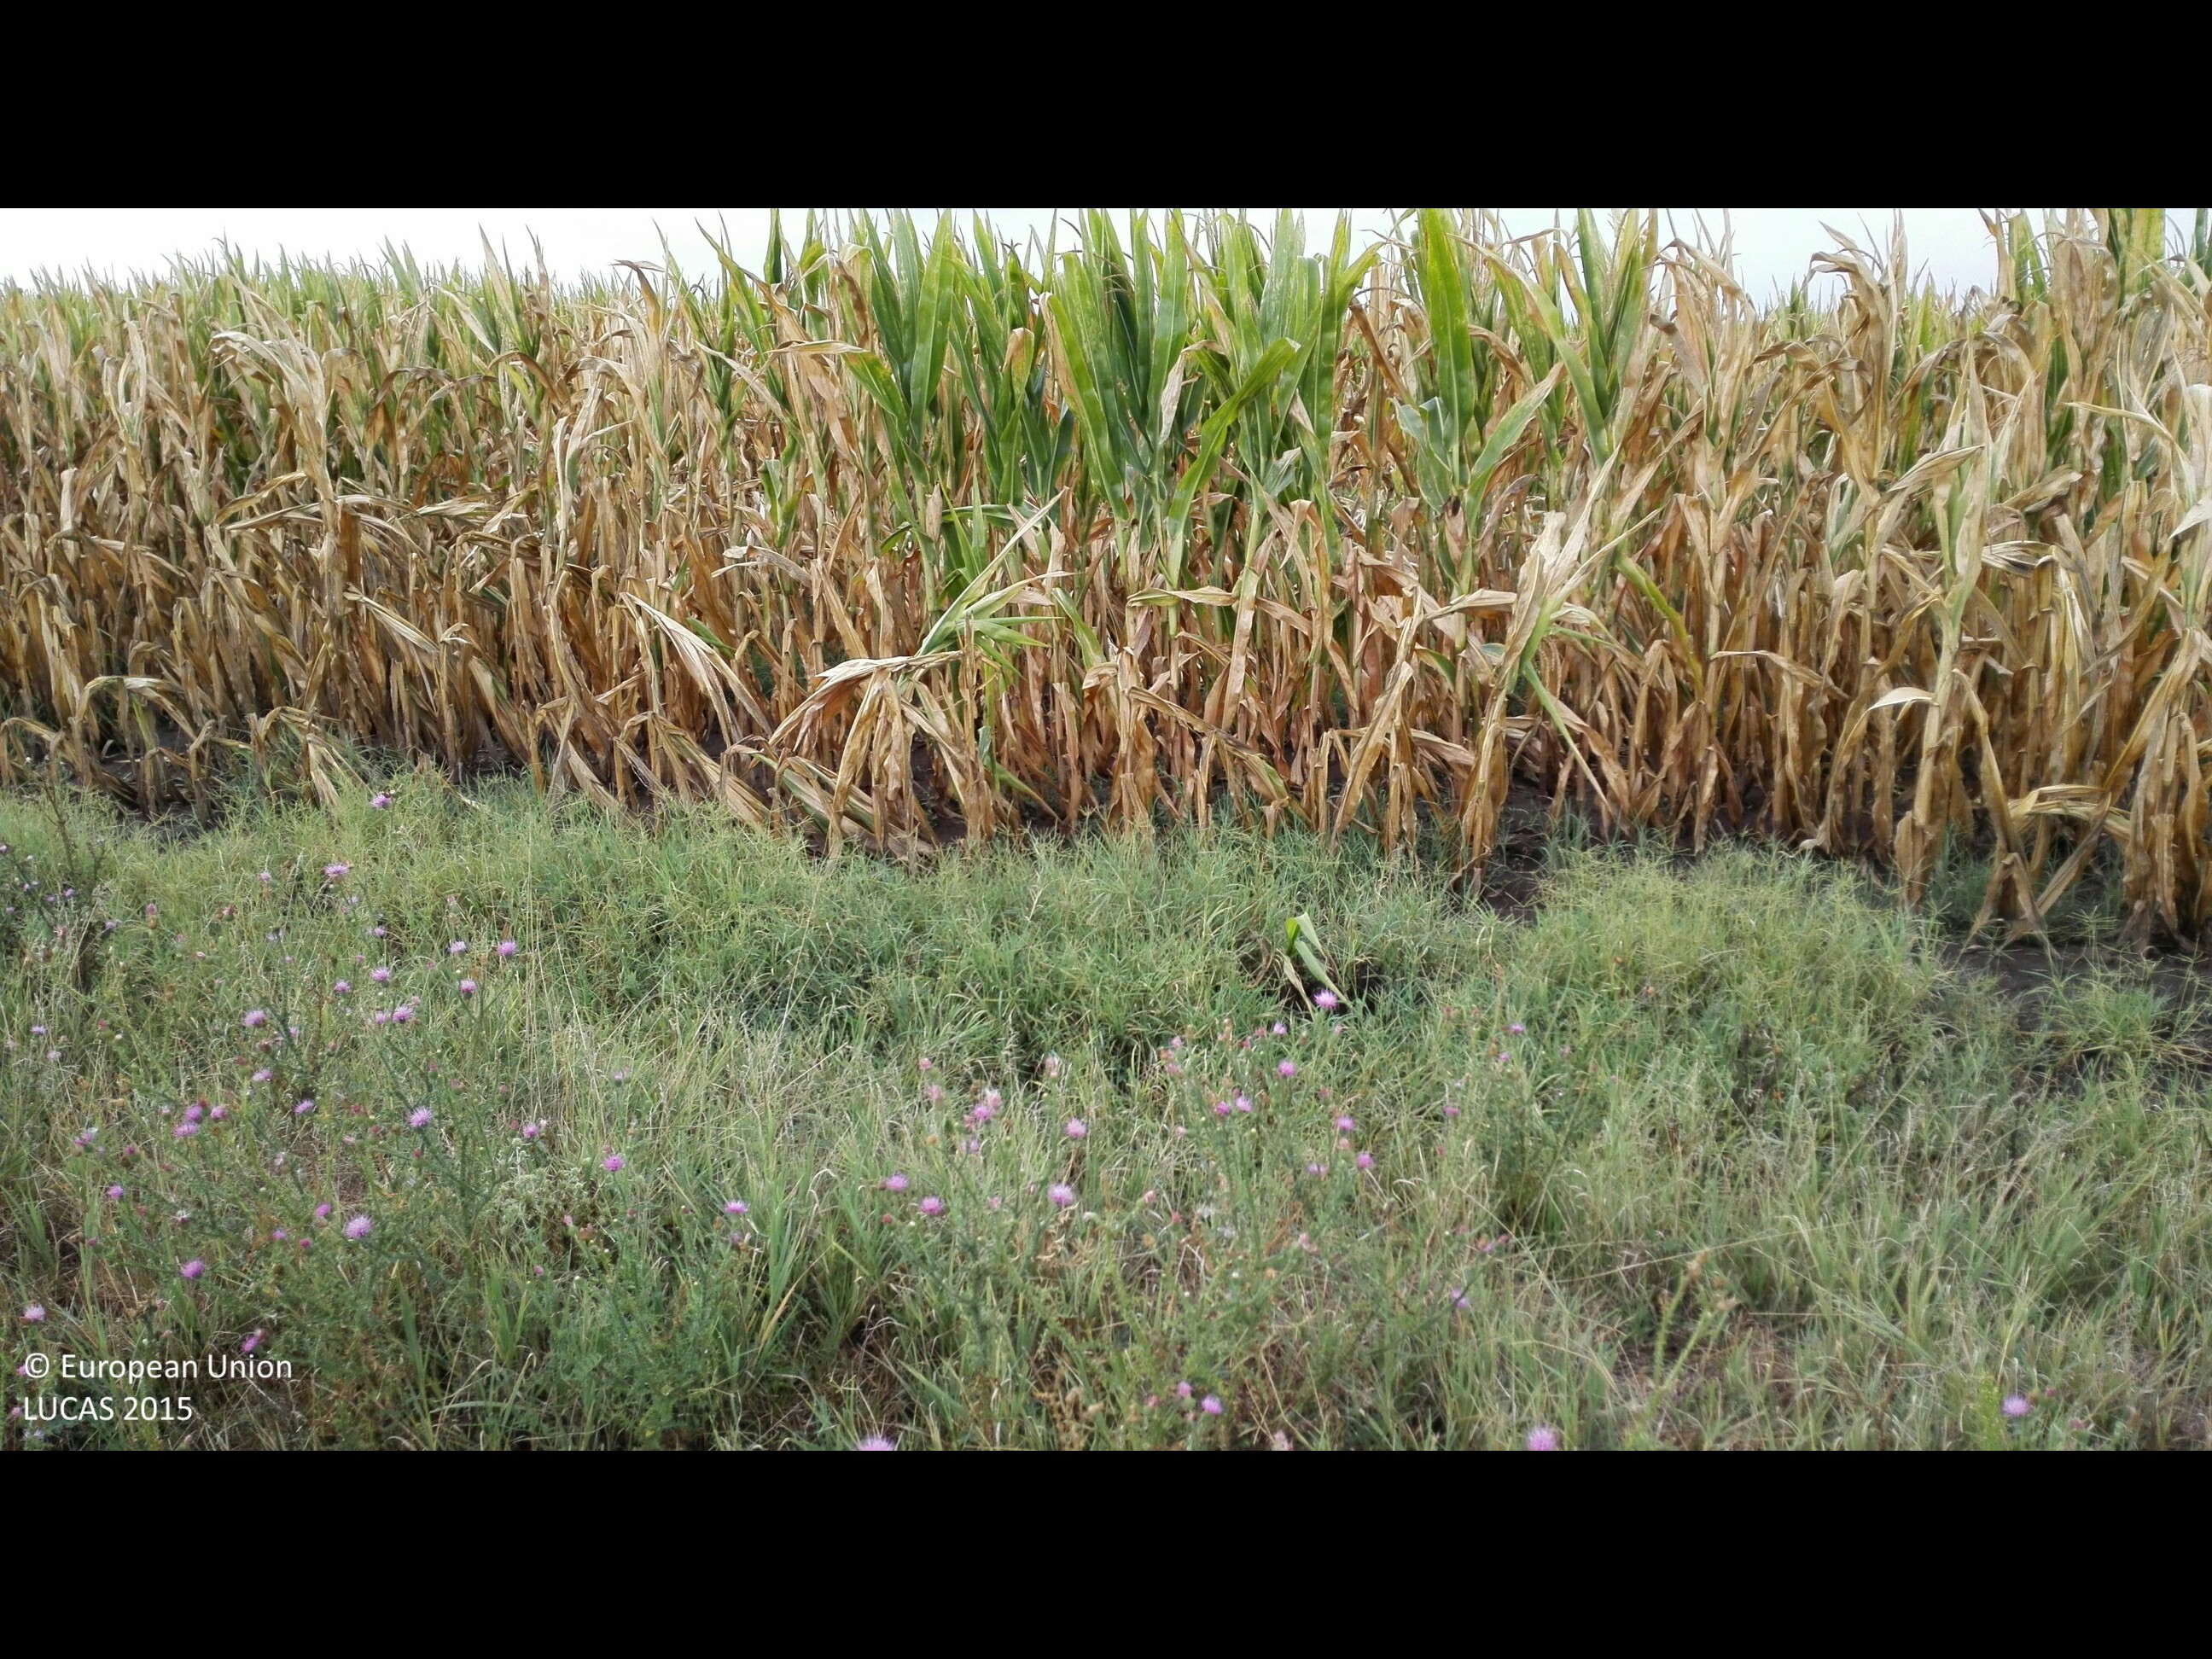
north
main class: Grassland
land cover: Grassland without tree/shrub cover
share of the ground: > 75 %
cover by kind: herbaceous plants 100 %
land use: Agriculture (excluding fallow land and kitchen gardens)
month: August
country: HU
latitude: 47.3365
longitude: 21.5968
